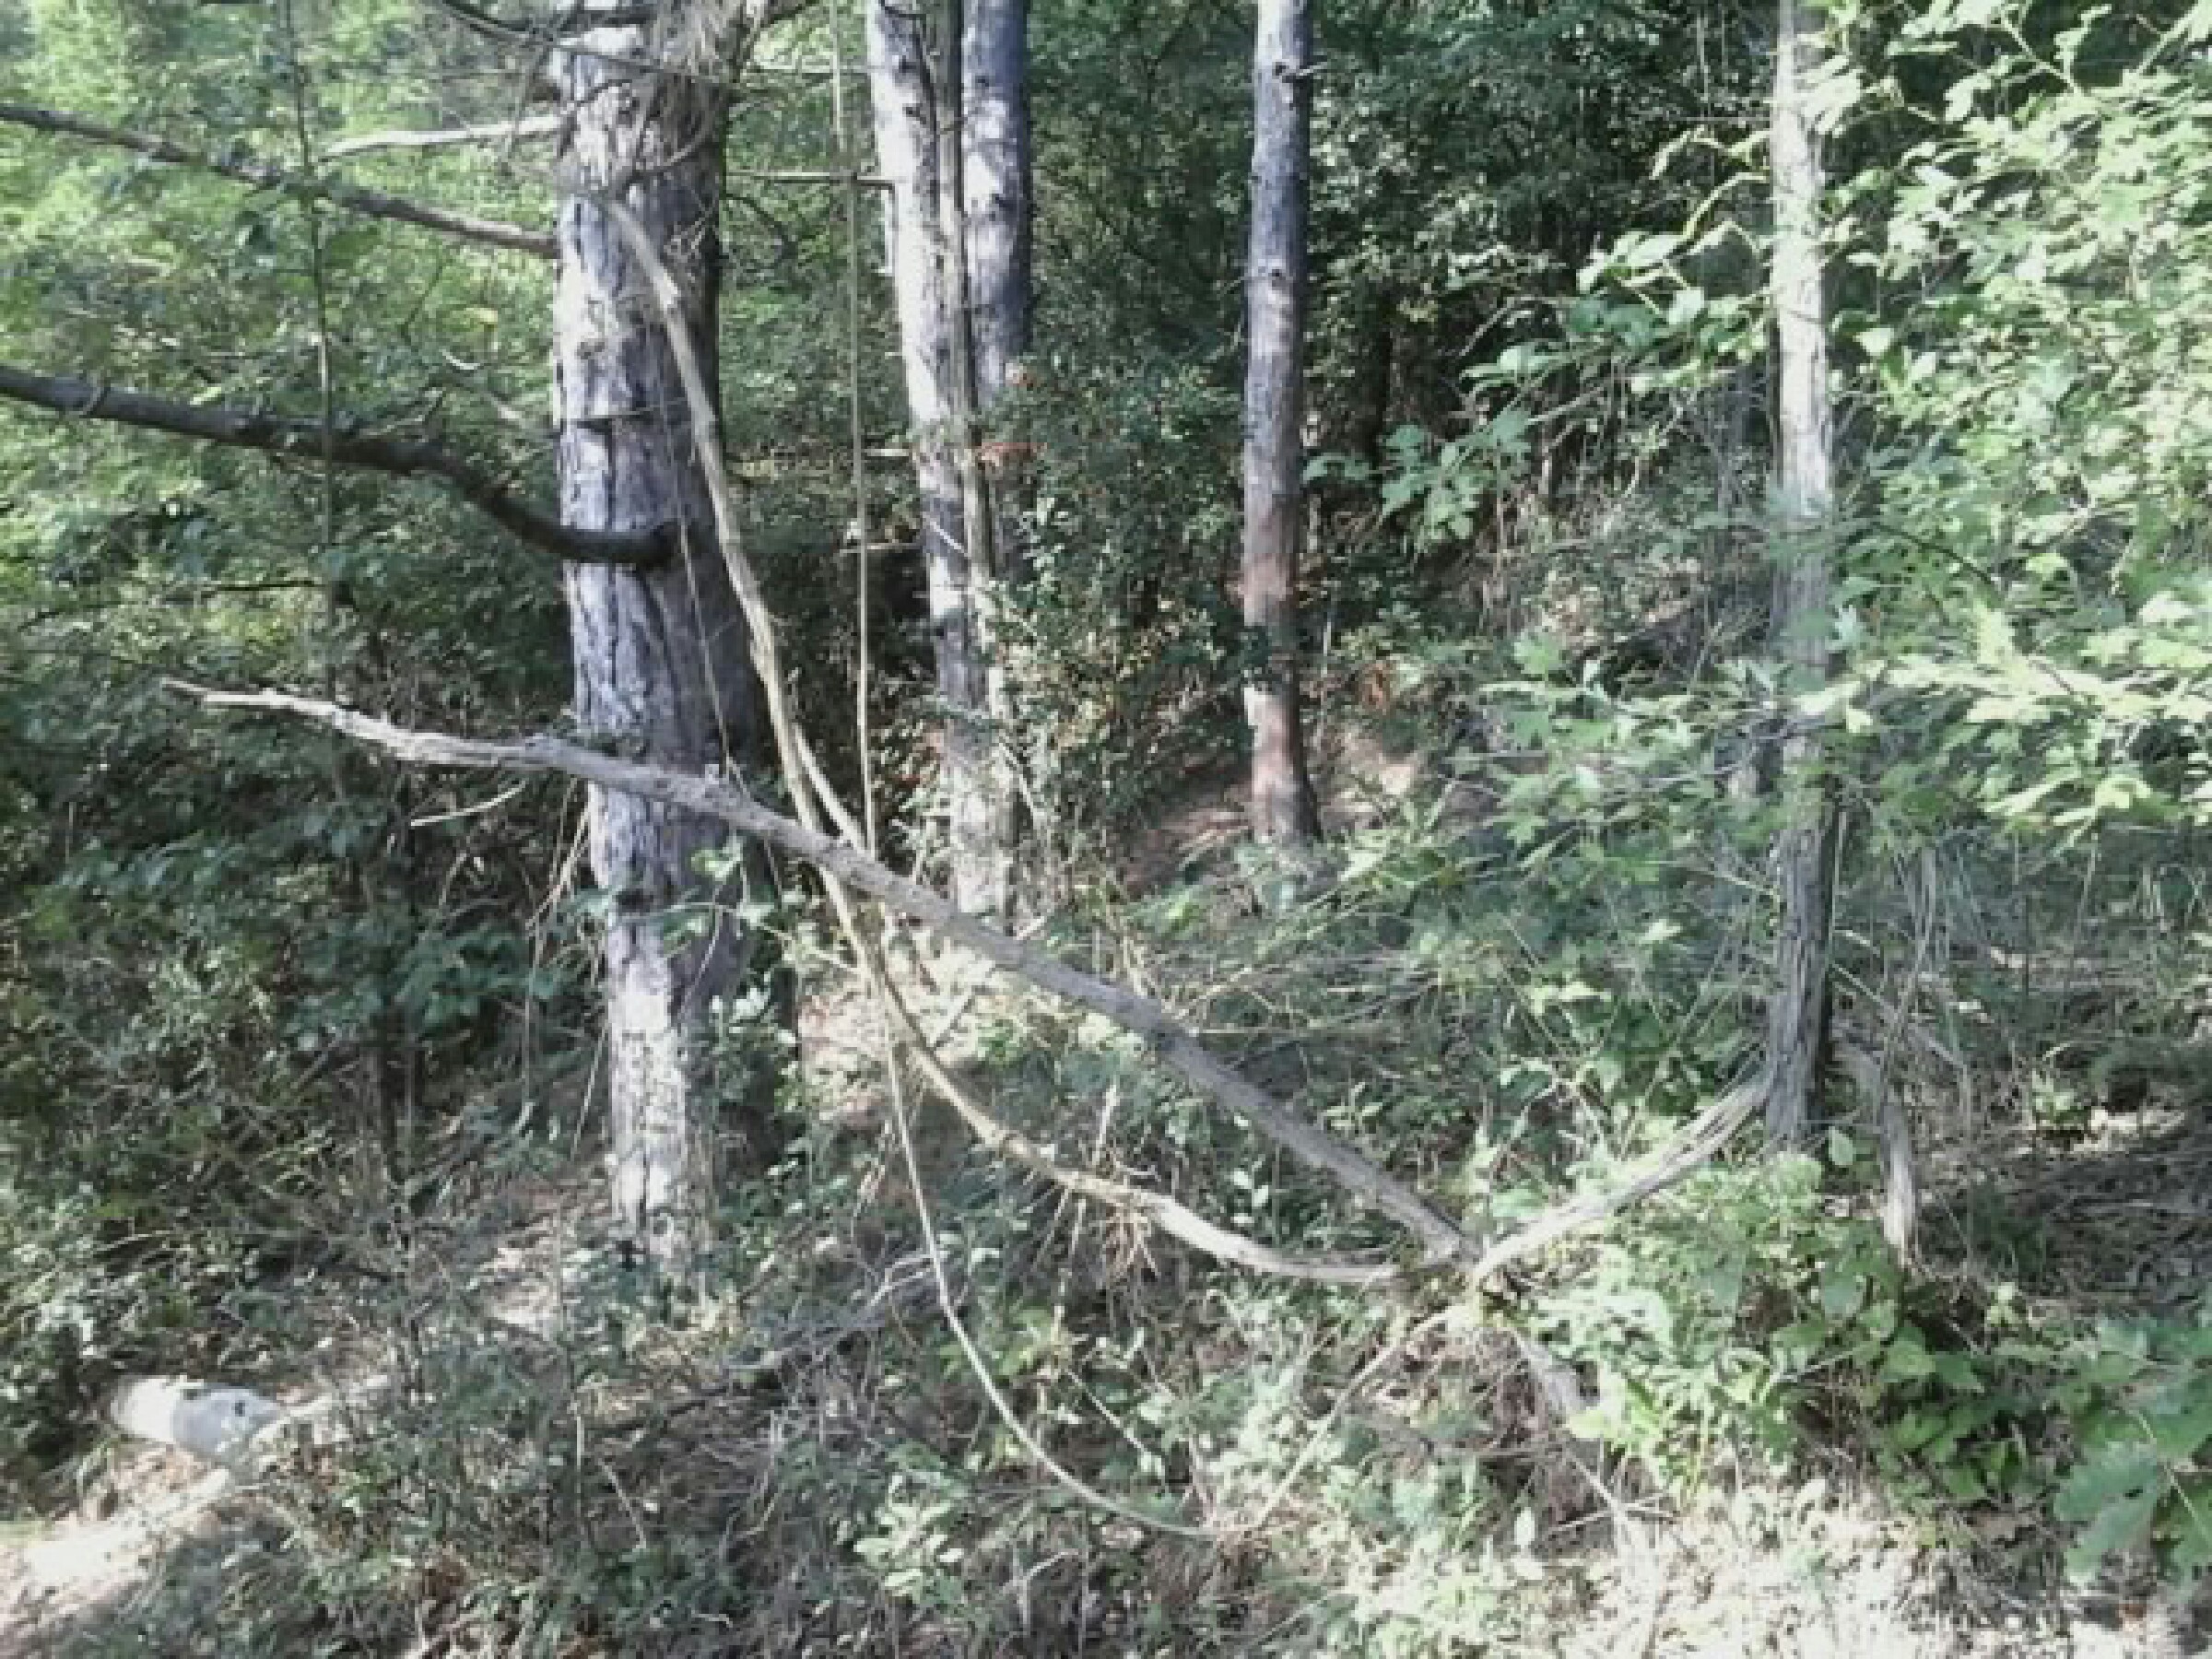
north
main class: Woodland
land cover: Pine dominated mixed woodland
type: hemiboreal forest and nemoral coniferous forest and mixed broadleaved-coniferous forest
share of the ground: > 75 %
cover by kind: coniferous forest trees 60 %, broadleaved forest trees 40 %
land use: Forestry
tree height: > 5 m
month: August
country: HU
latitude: 47.9806
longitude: 19.4412
